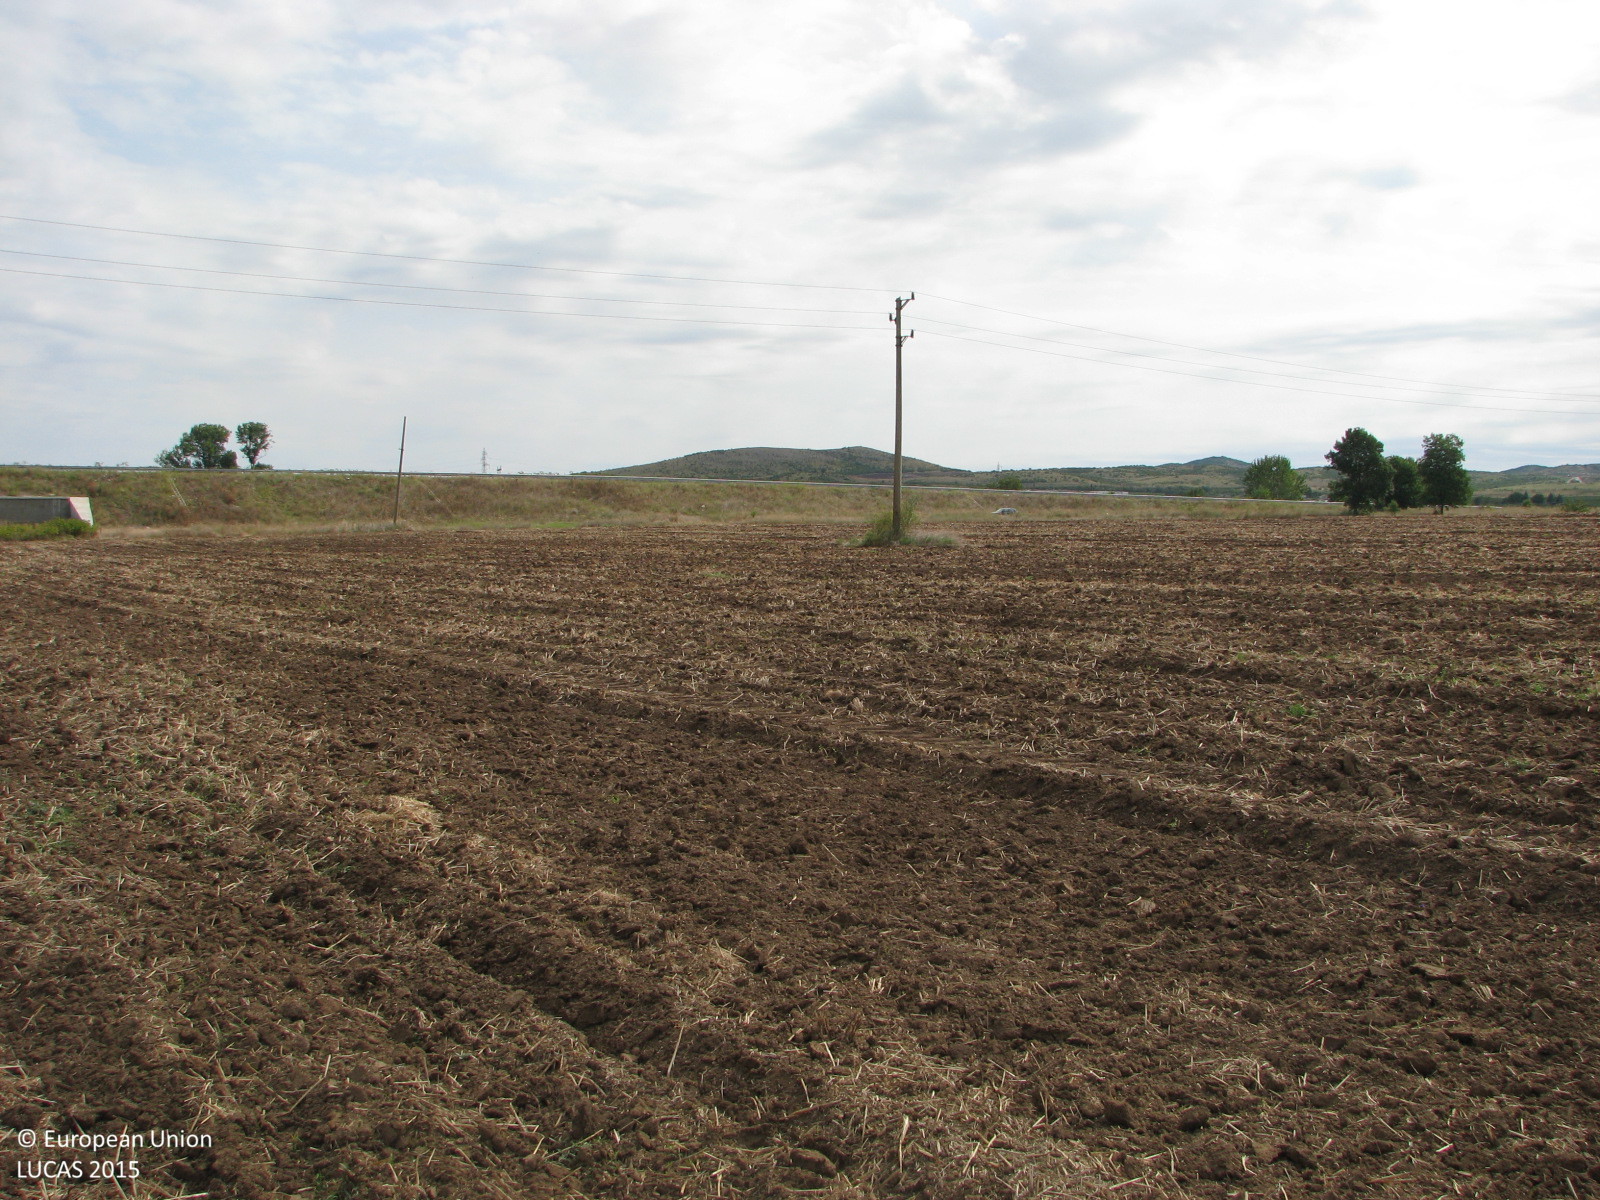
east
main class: Cropland
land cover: Common wheat
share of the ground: < 10 %
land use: Agriculture (excluding fallow land and kitchen gardens)
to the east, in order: Common wheat; Electric lines; Common wheat; Grass margins; Other bare soil; Tracks; Grass margins; Ditches and canals; Electric lines; Grassland without tree/shrub cover; Paved roads, cycling and walking lanes
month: September
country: BG
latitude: 42.4492
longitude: 26.0455
